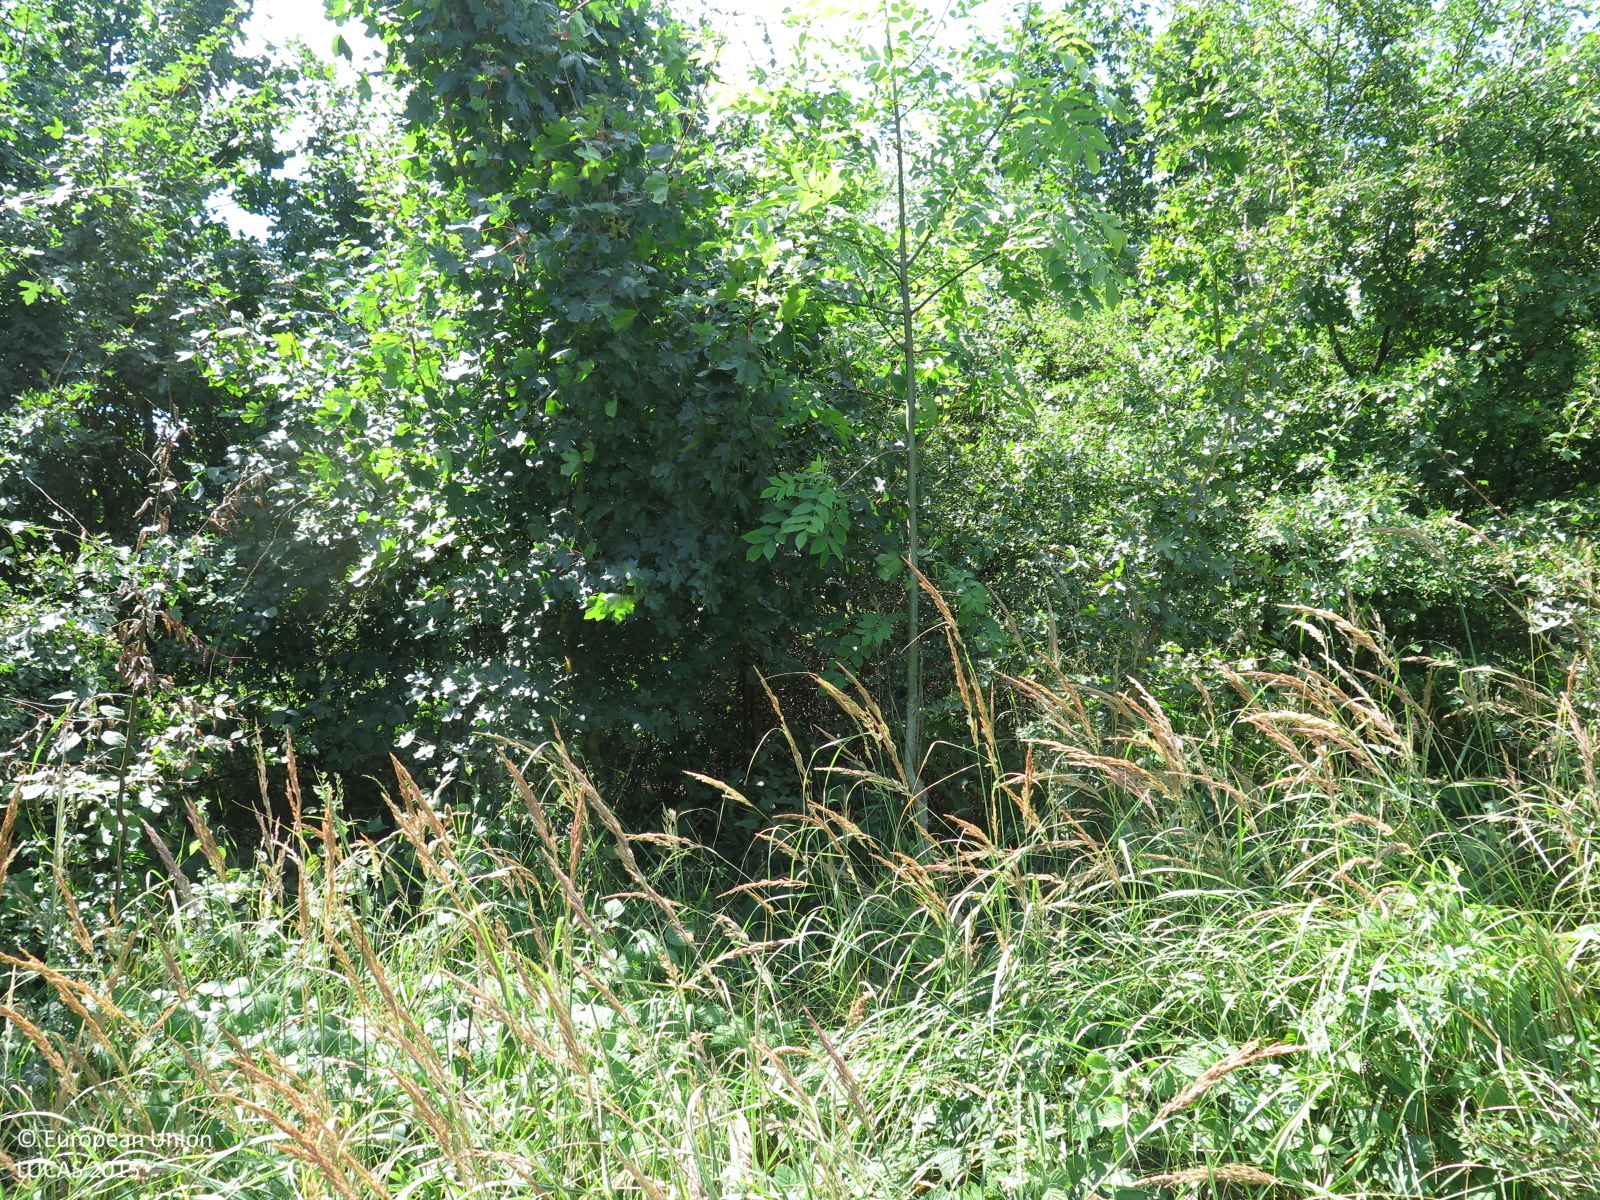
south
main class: Shrubland
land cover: Shrubland with sparse tree cover
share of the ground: > 75 %
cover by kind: shrubs 75 %, herbaceous plants 20 %, broadleaved forest trees 5 %
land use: Abandoned areas
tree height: < 5 m
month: July
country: CZ
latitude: 48.9216
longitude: 17.5587
